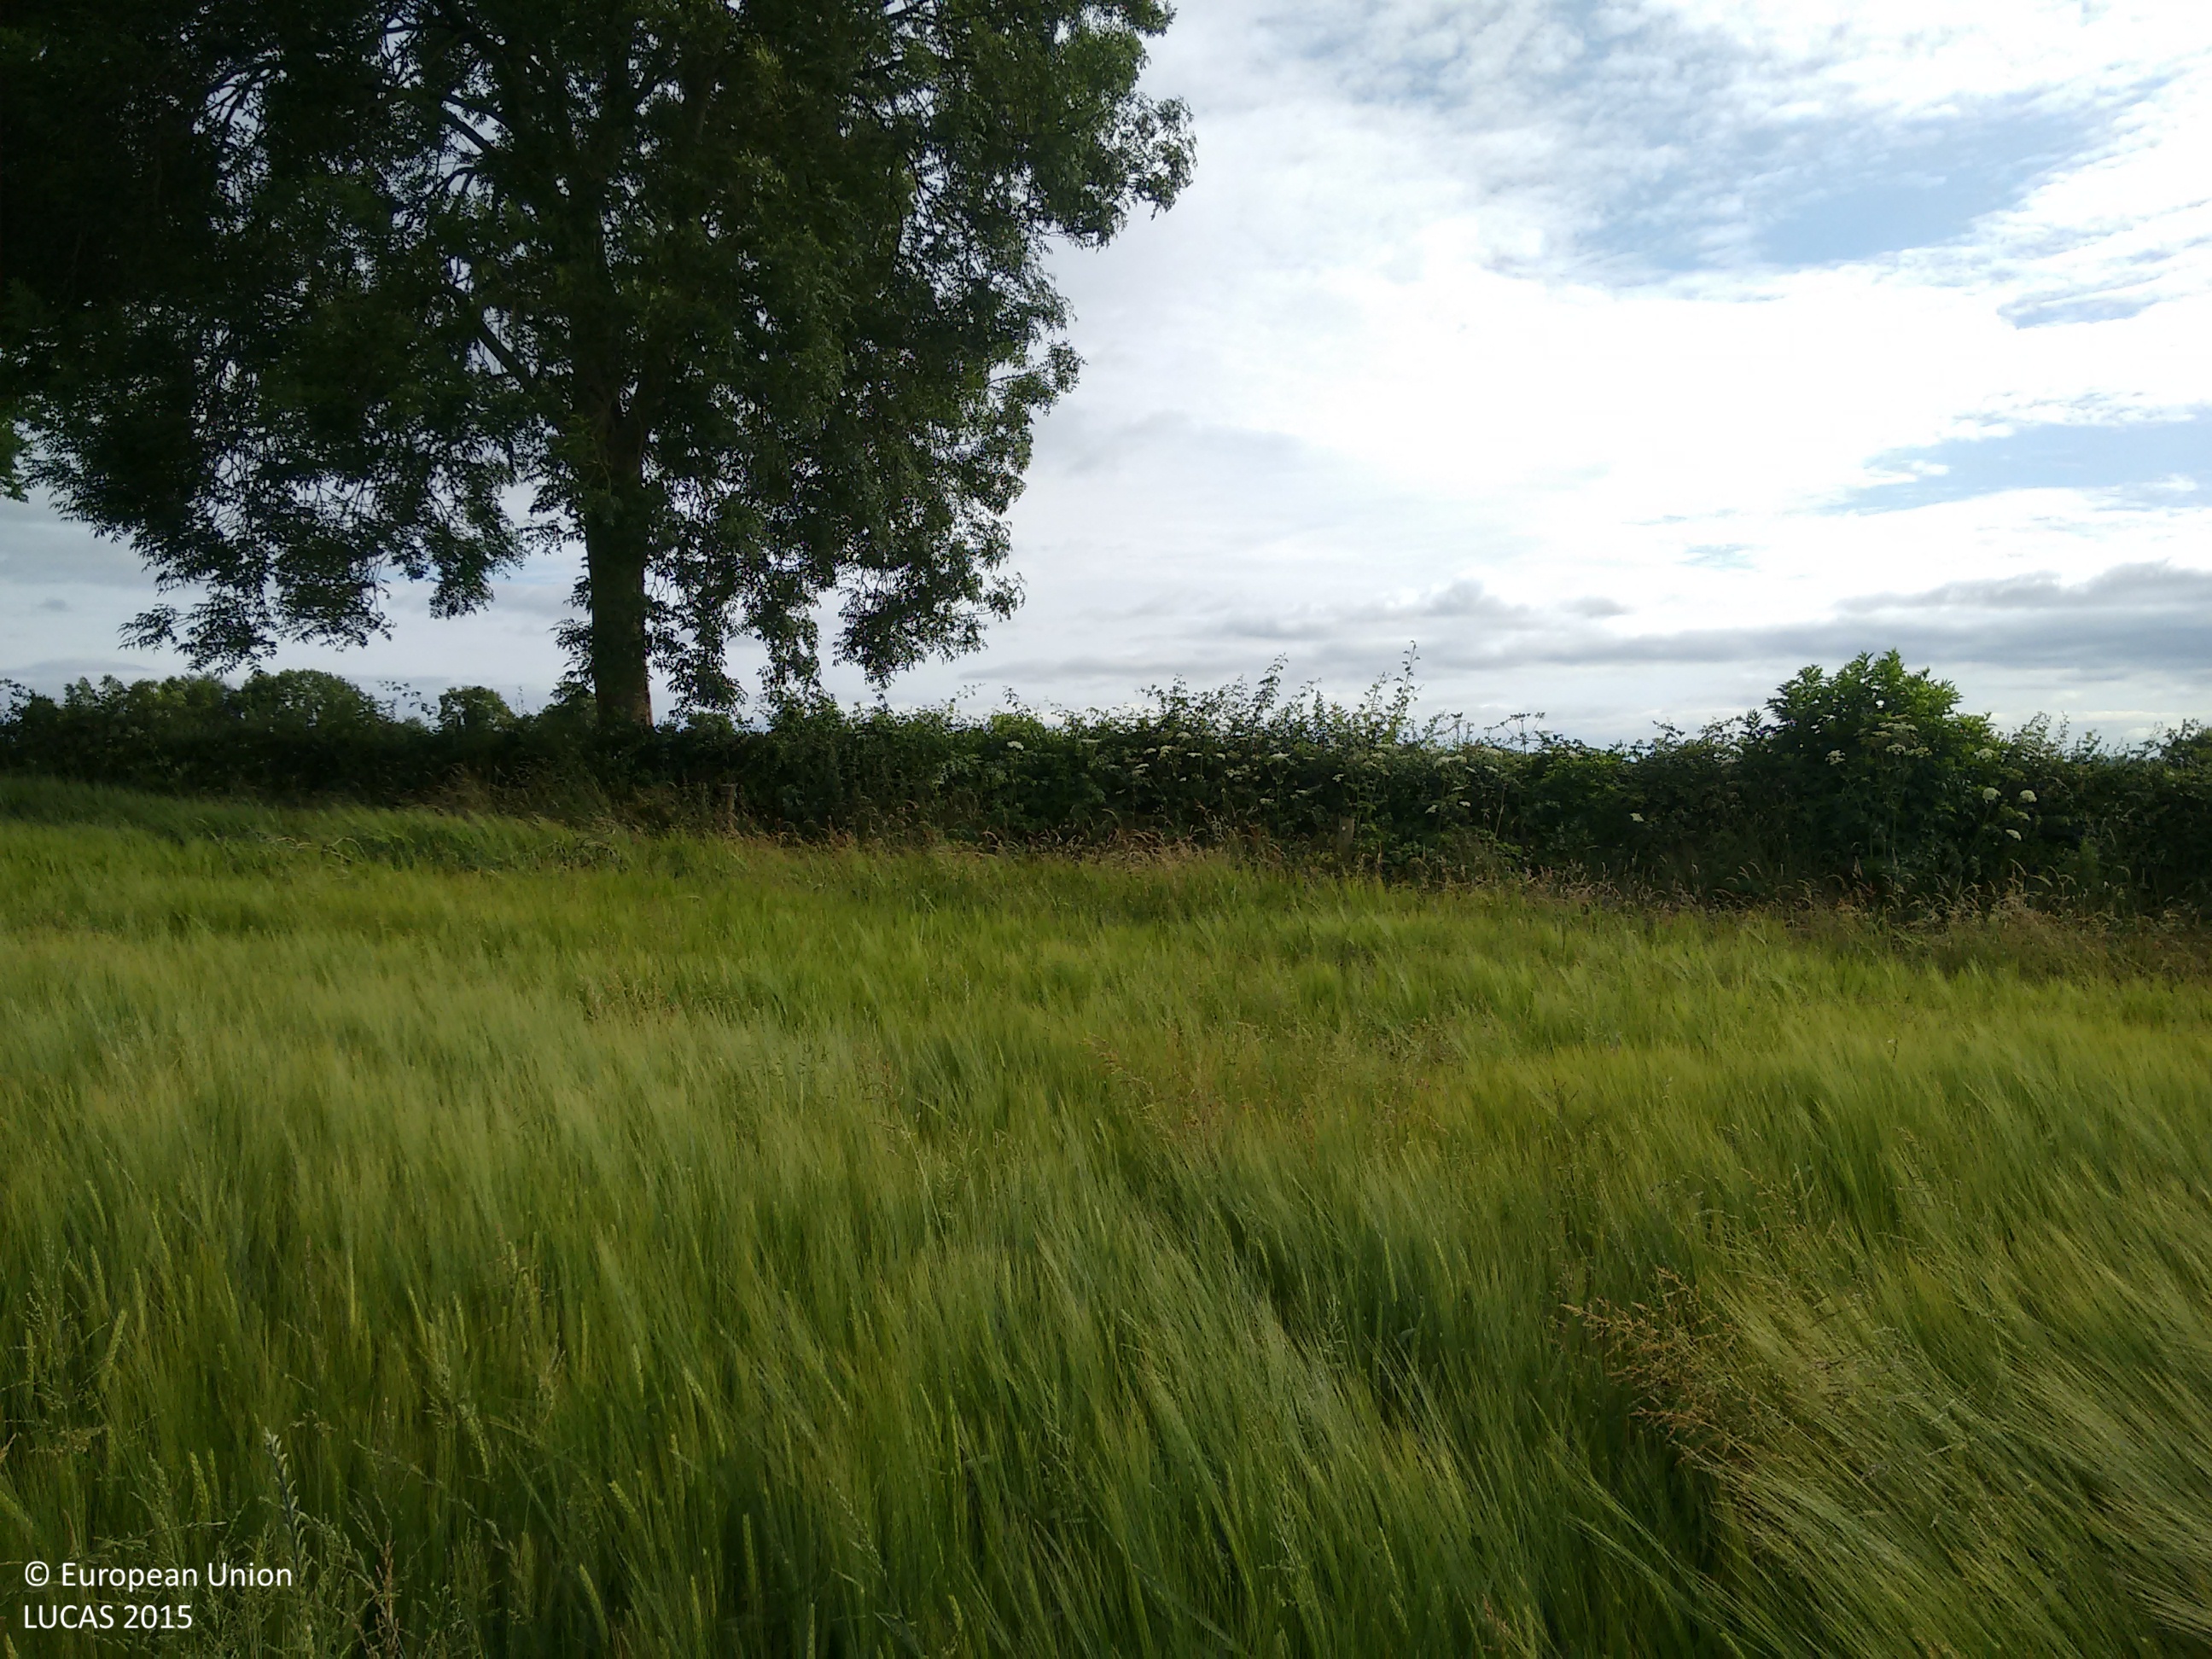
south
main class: Cropland
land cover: Barley
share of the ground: > 75 %
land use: Agriculture (excluding fallow land and kitchen gardens)
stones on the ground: < 10 %
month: July
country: IE
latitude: 53.4677
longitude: -7.8084
